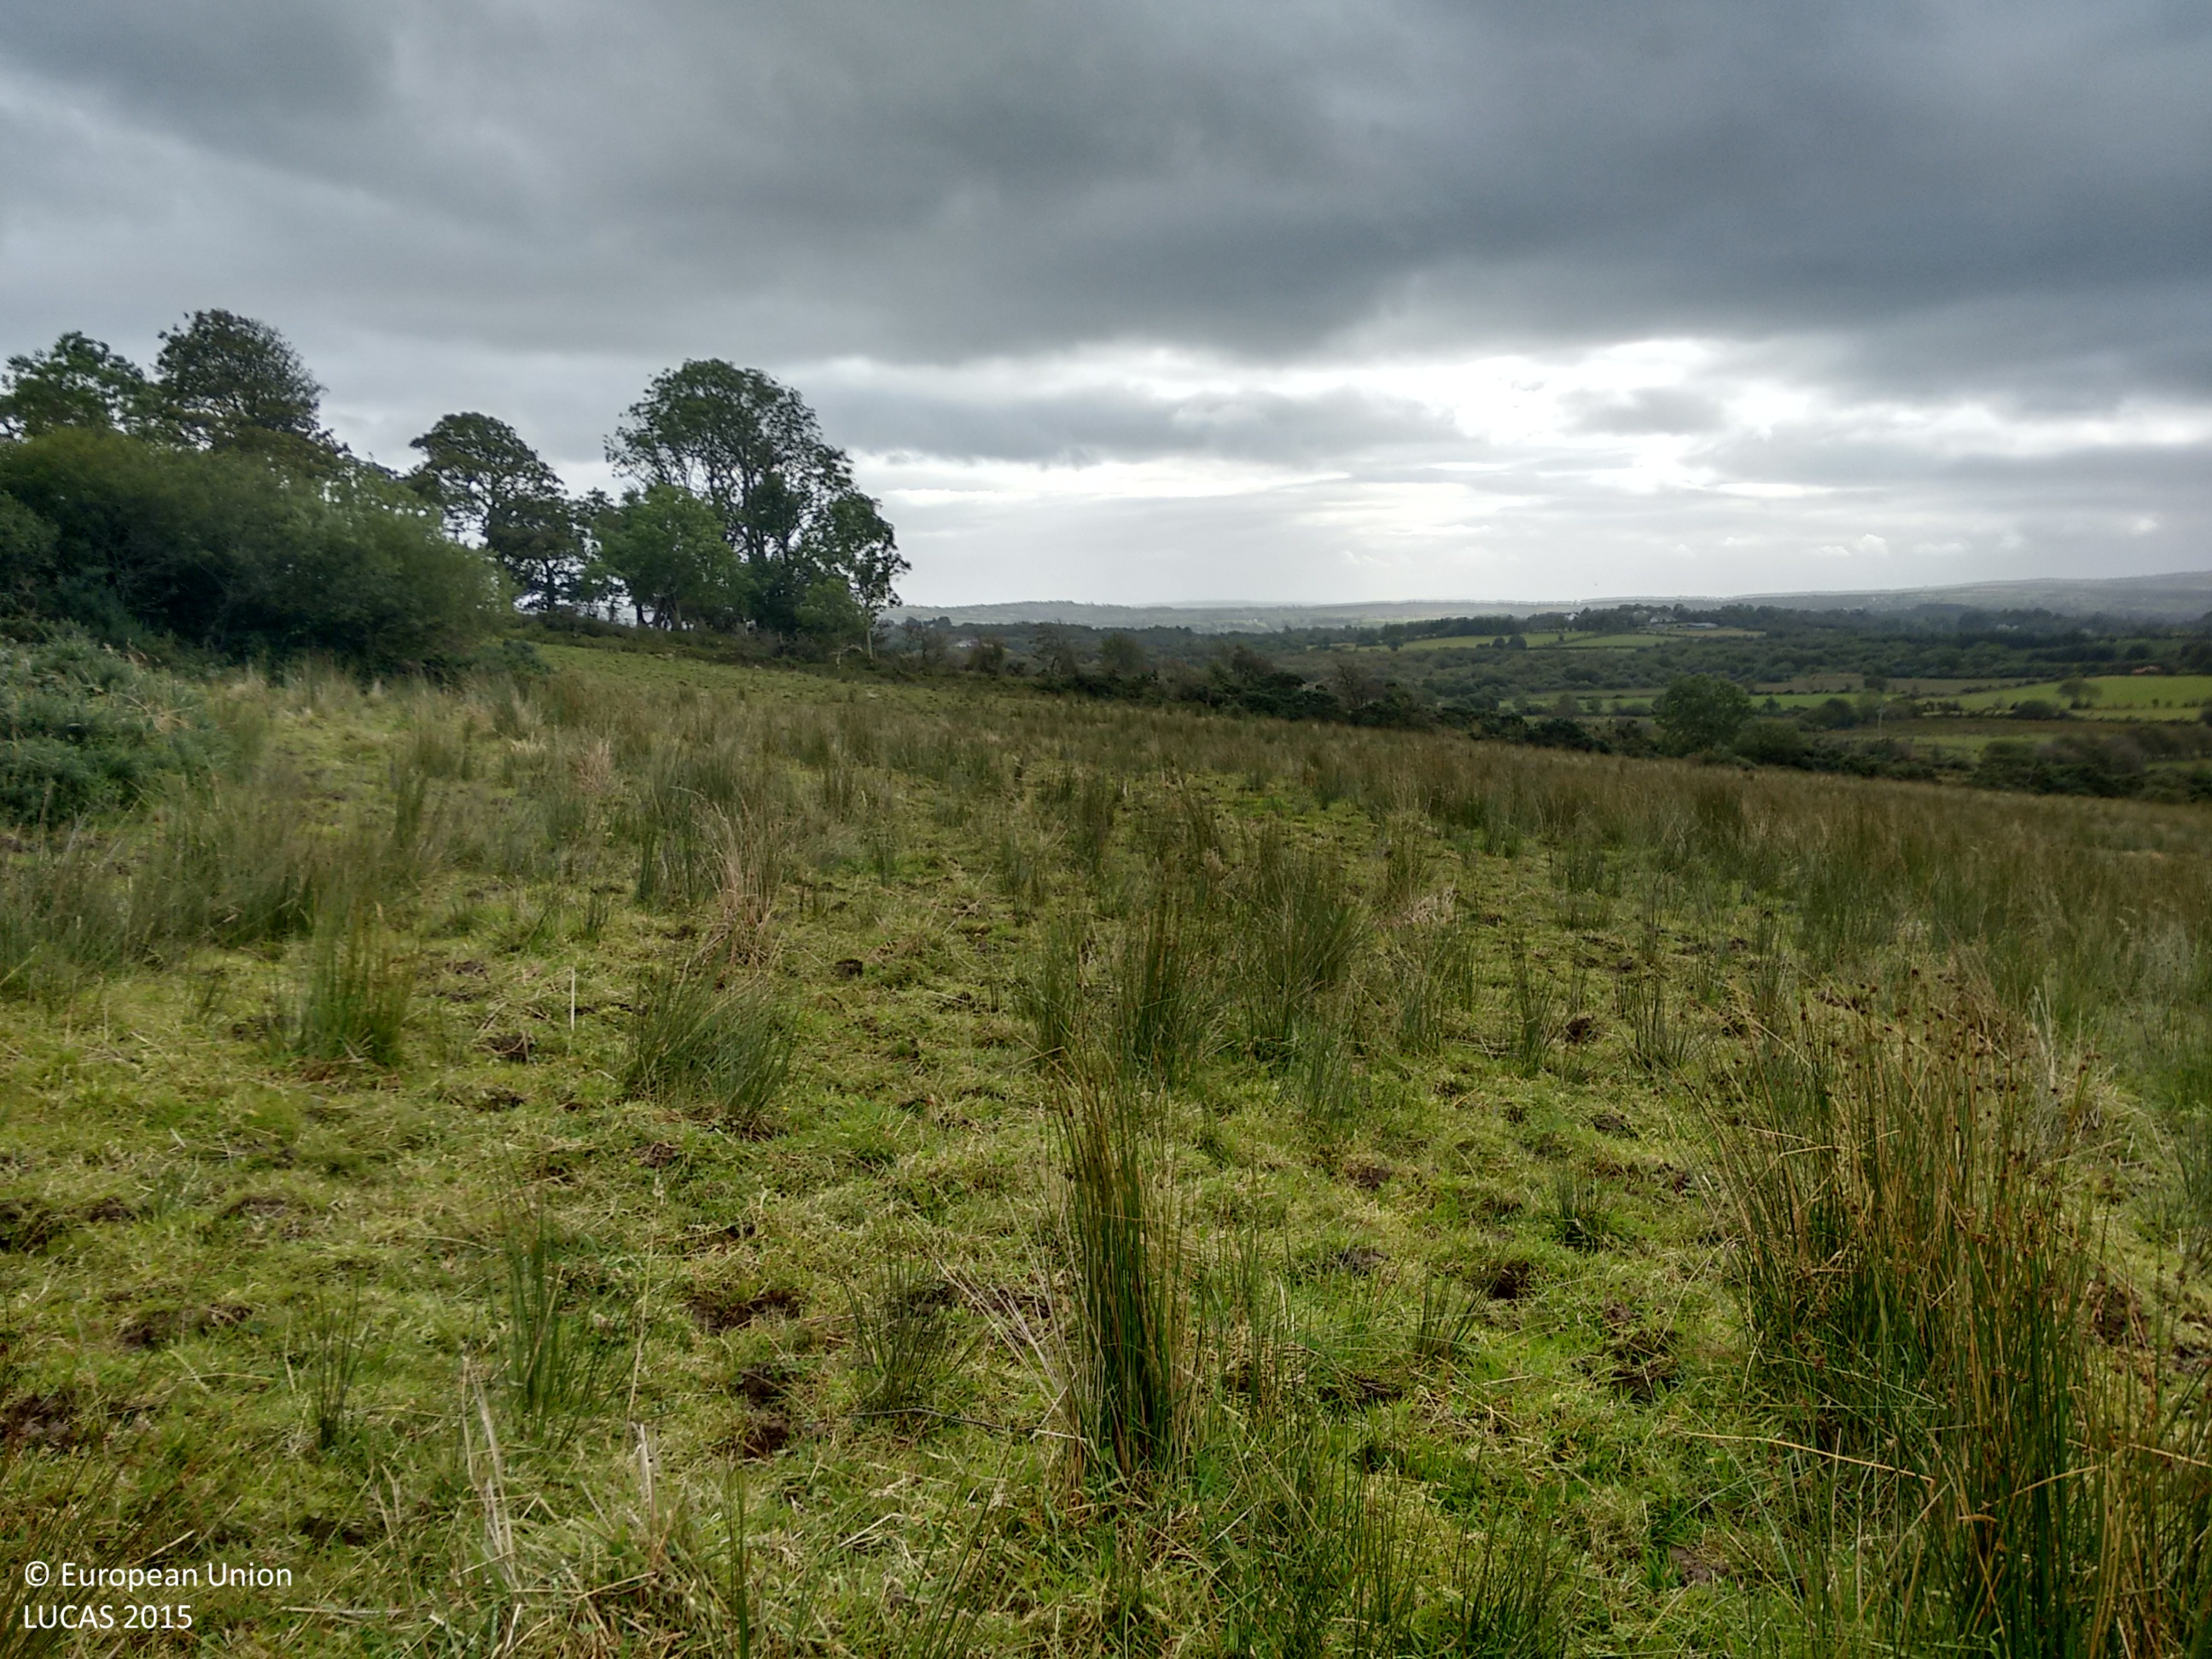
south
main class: Grassland
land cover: Grassland without tree/shrub cover
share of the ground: > 75 %
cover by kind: herbaceous plants 100 %
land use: Agriculture (excluding fallow land and kitchen gardens)
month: September
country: IE
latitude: 55.0775
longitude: -7.6548
